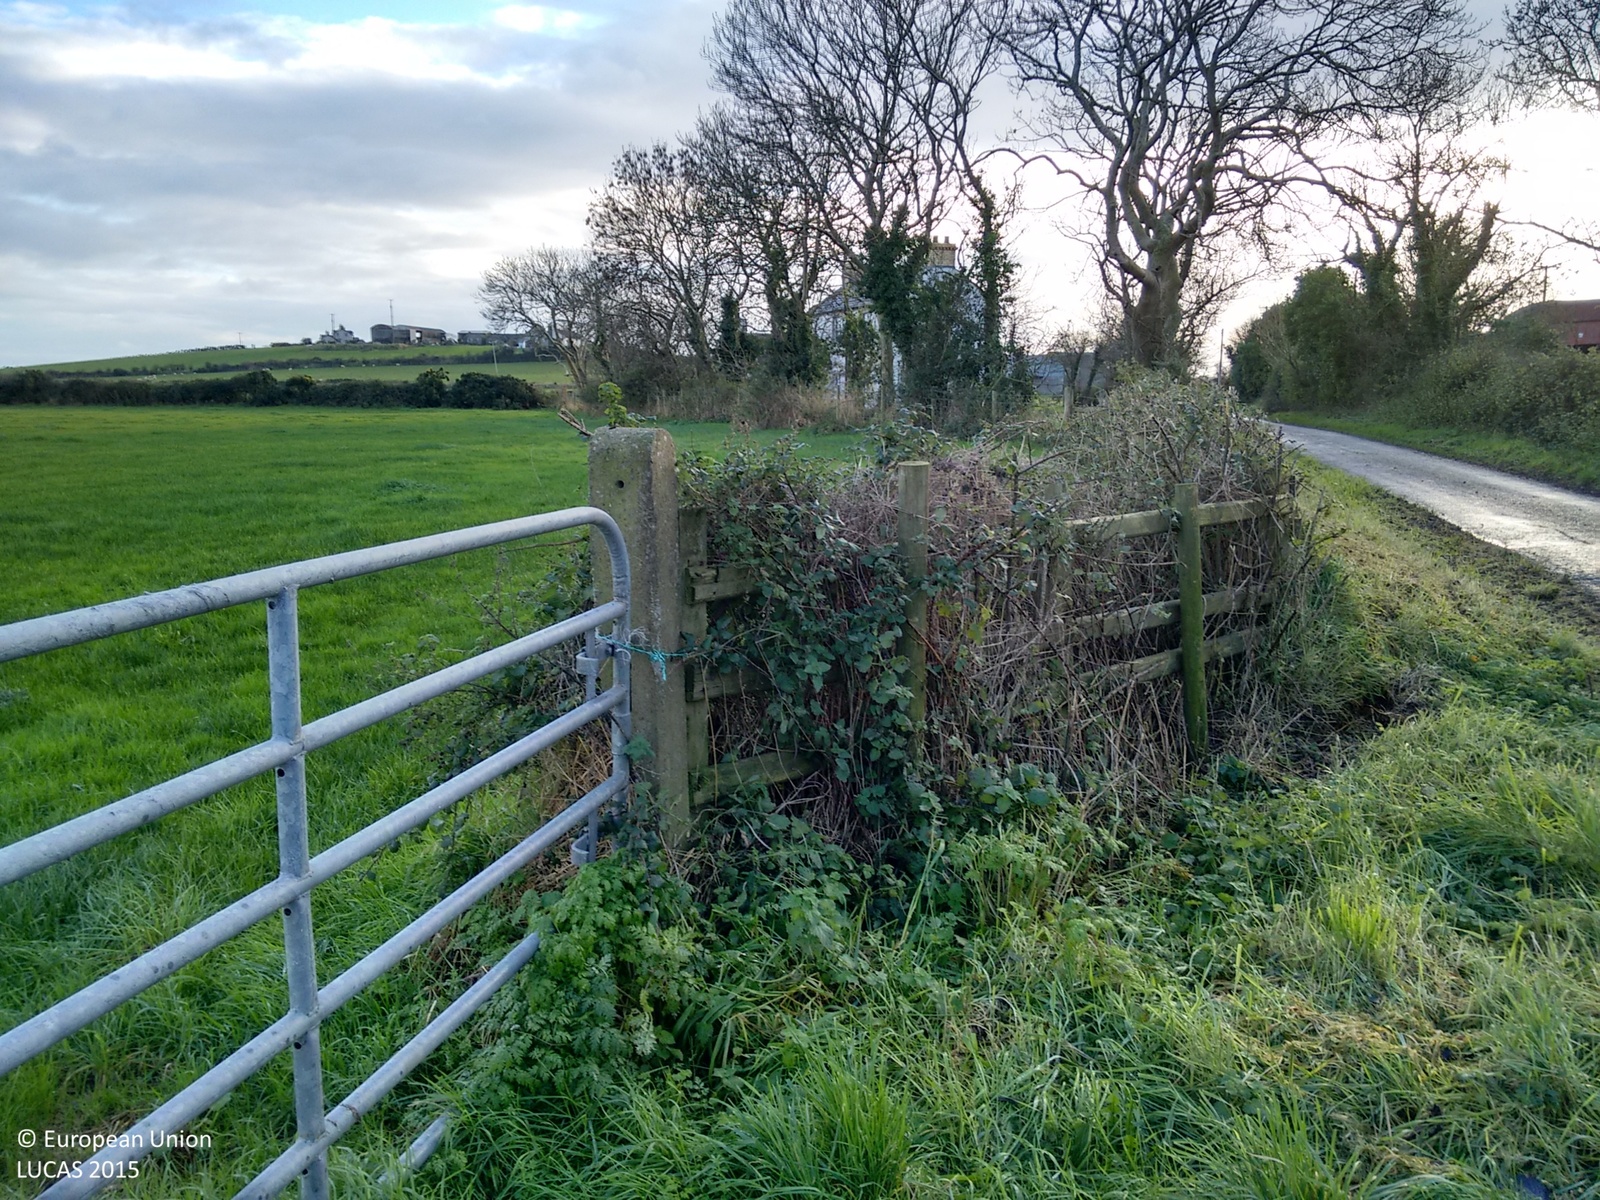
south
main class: Grassland
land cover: Grassland without tree/shrub cover
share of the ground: > 75 %
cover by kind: herbaceous plants 100 %
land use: Agriculture (excluding fallow land and kitchen gardens)
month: November
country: GB
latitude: 54.5220
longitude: -5.4998
